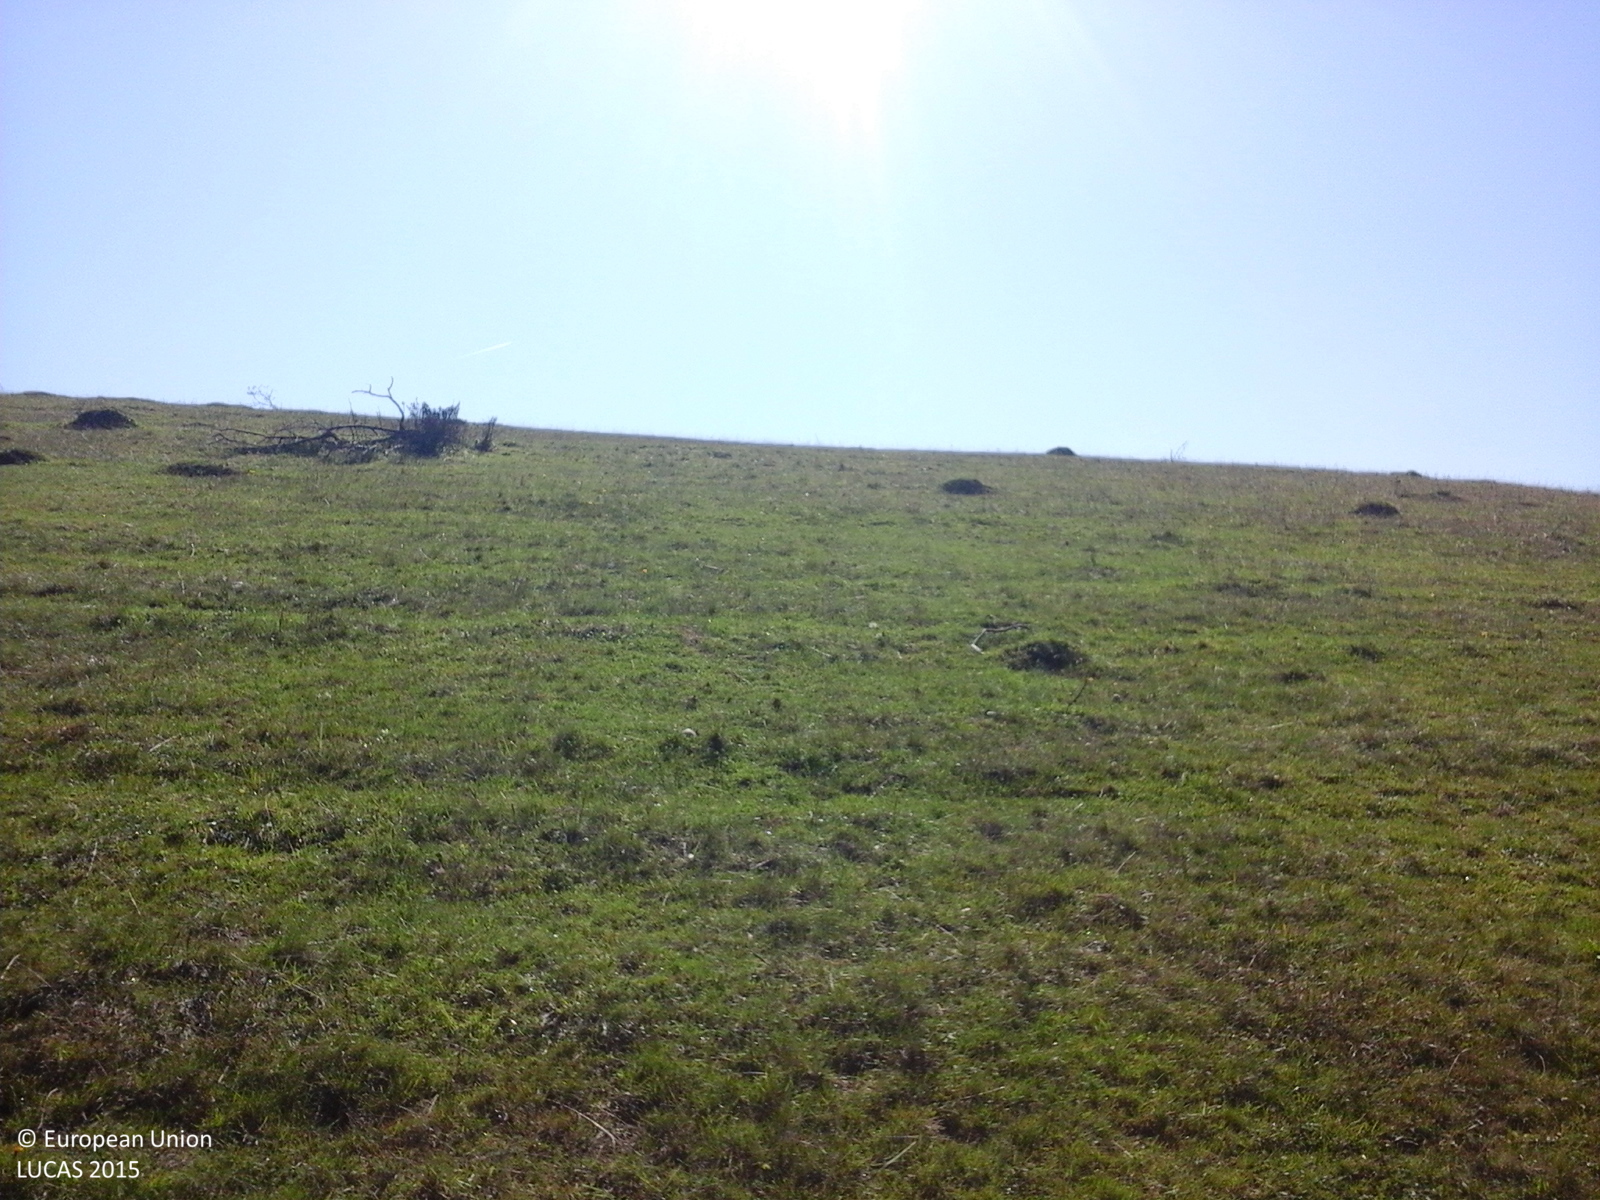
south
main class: Grassland
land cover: Grassland without tree/shrub cover
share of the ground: > 75 %
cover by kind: herbaceous plants 100 %
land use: Agriculture (excluding fallow land and kitchen gardens)
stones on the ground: < 10 %
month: October
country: RO
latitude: 46.5618
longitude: 23.5444
